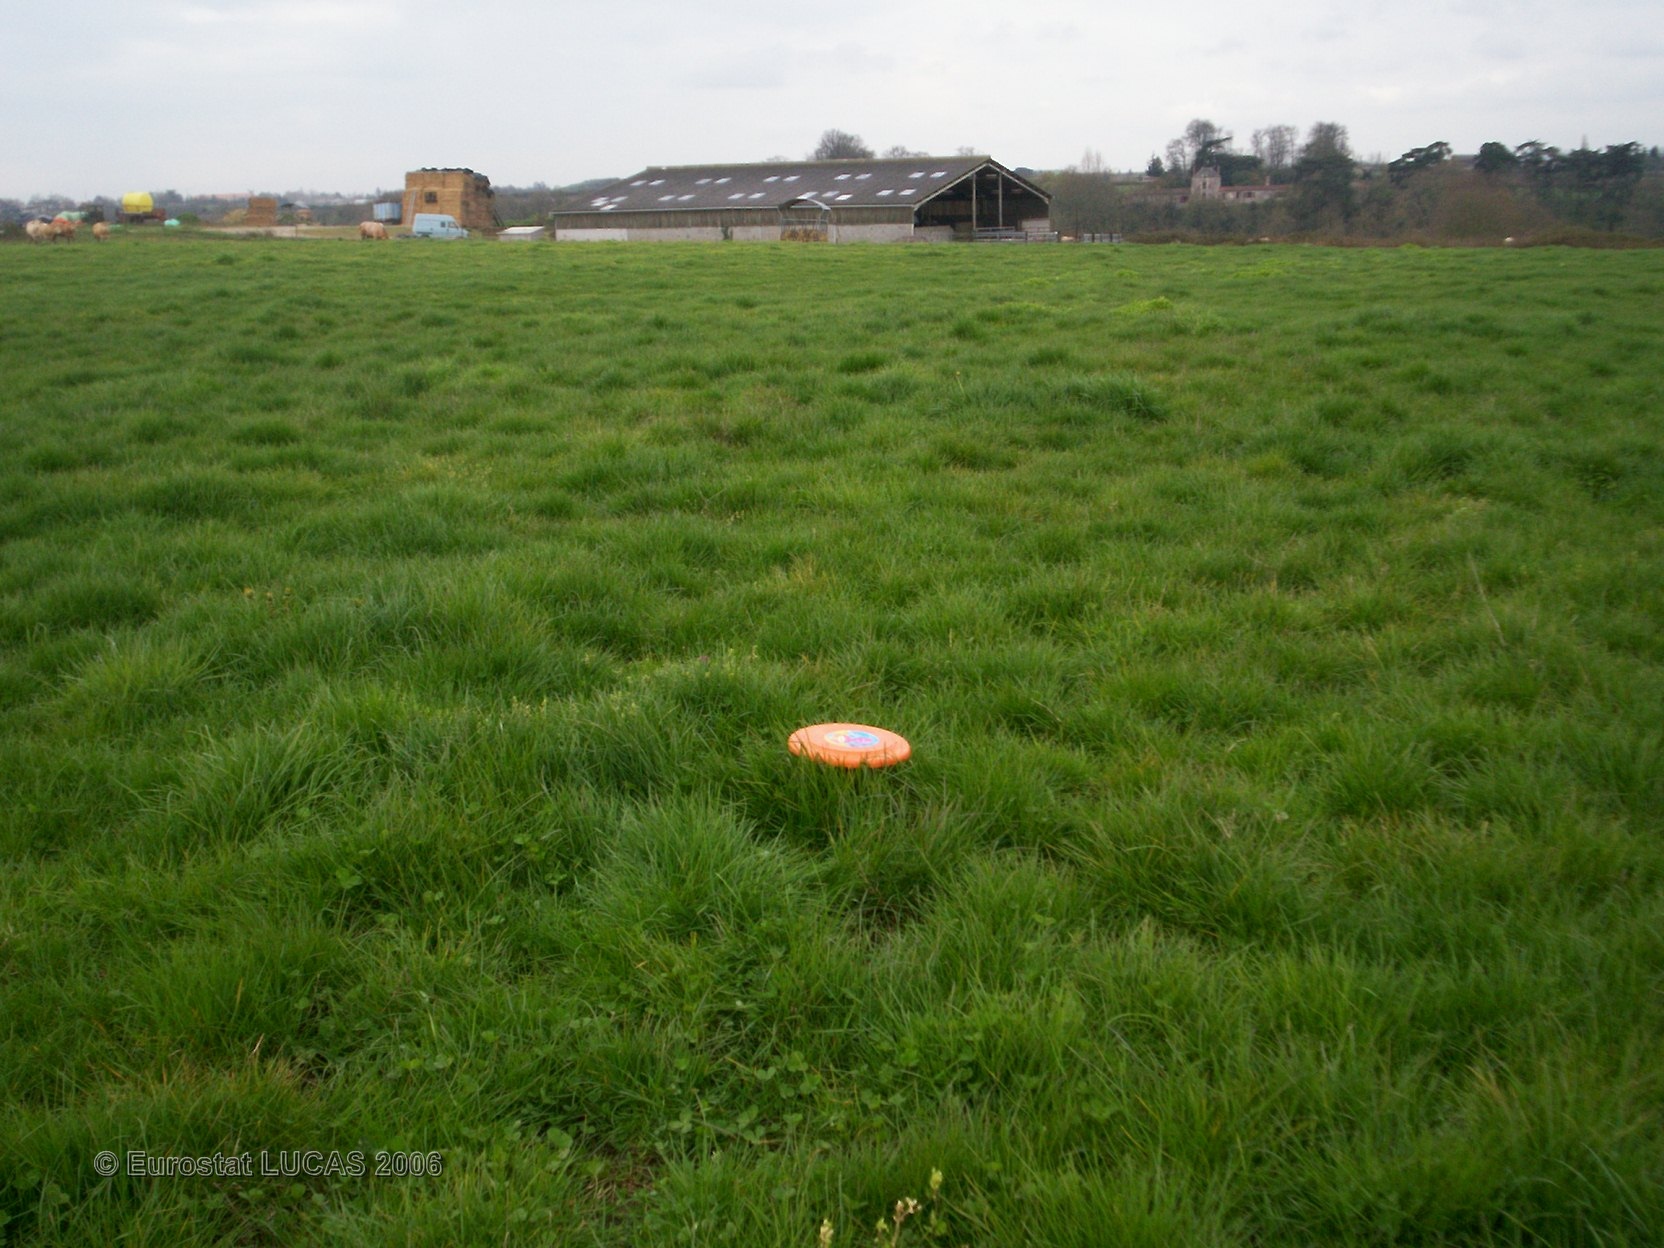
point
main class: Grassland
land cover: Grassland without tree/shrub cover
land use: Agriculture (excluding fallow land and kitchen gardens)
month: April
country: FR
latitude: 47.1129
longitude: -1.3064
